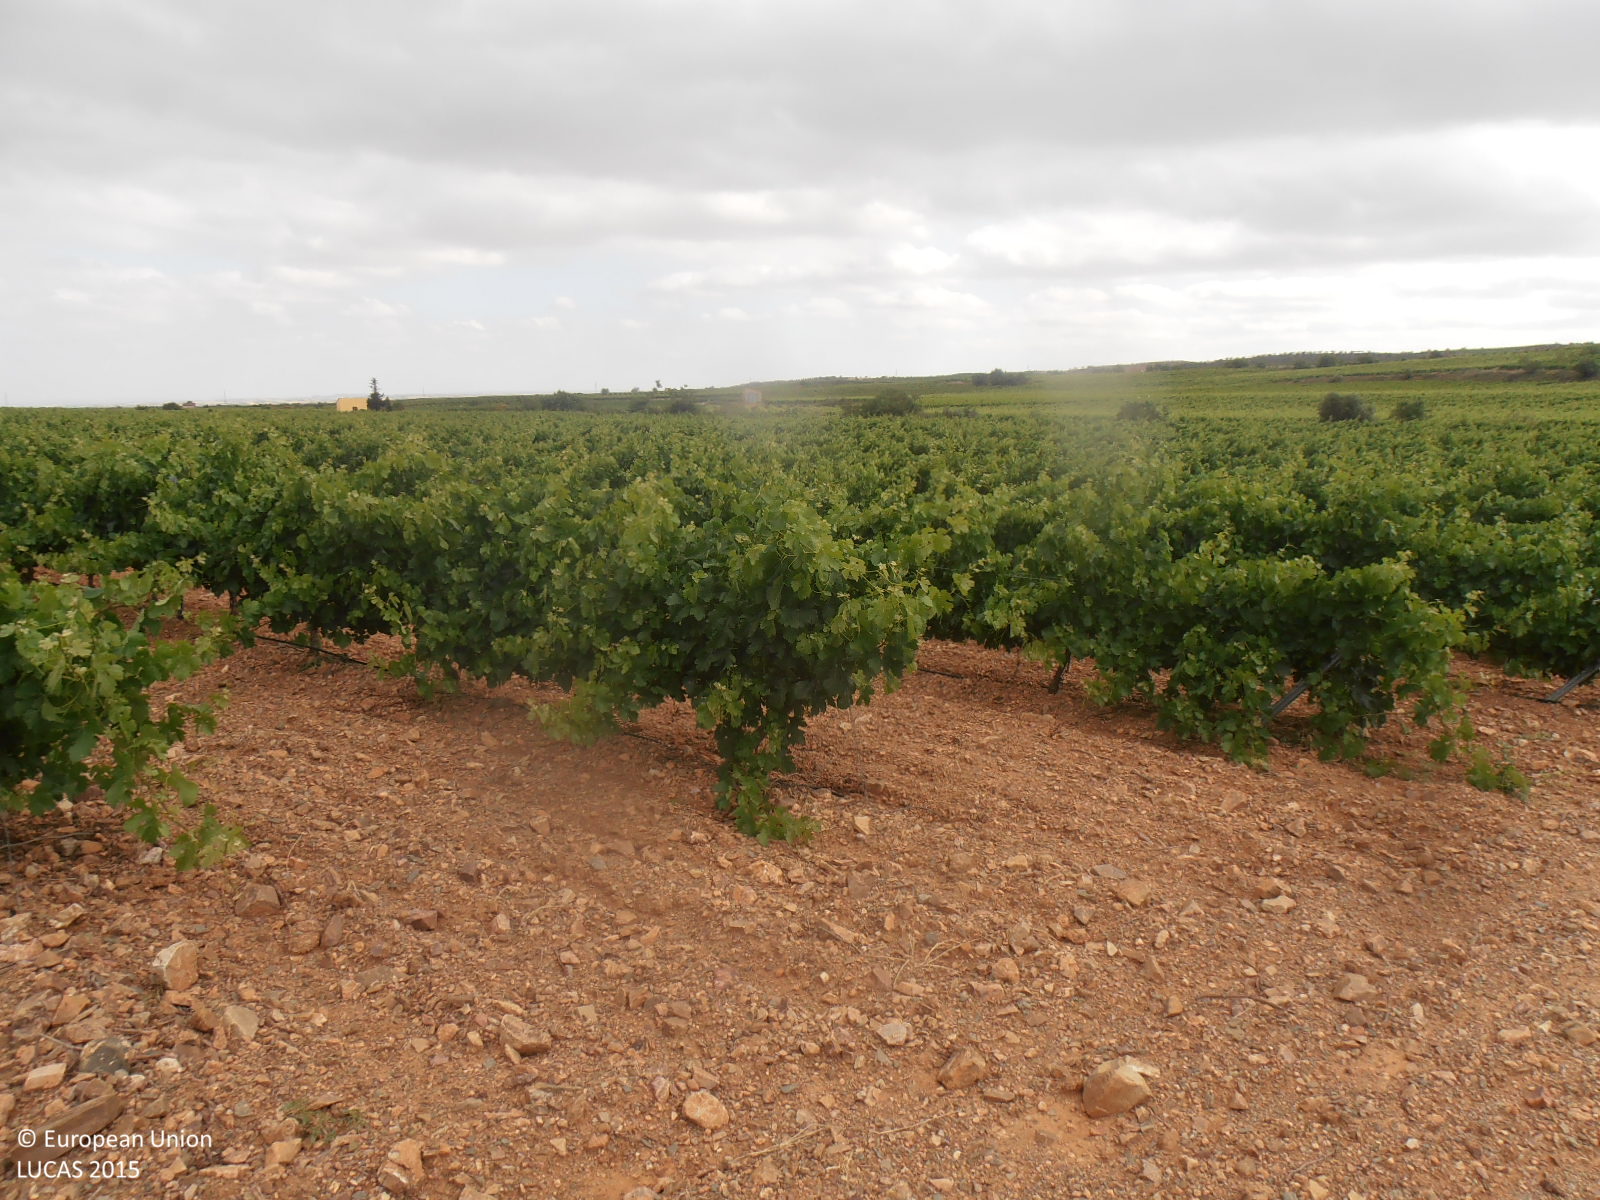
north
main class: Cropland
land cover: Vineyards
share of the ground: 25 - 50 %
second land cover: Other bare soil
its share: > 75 %
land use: Agriculture (excluding fallow land and kitchen gardens)
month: June
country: ES
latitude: 41.3033
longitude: -1.1880
